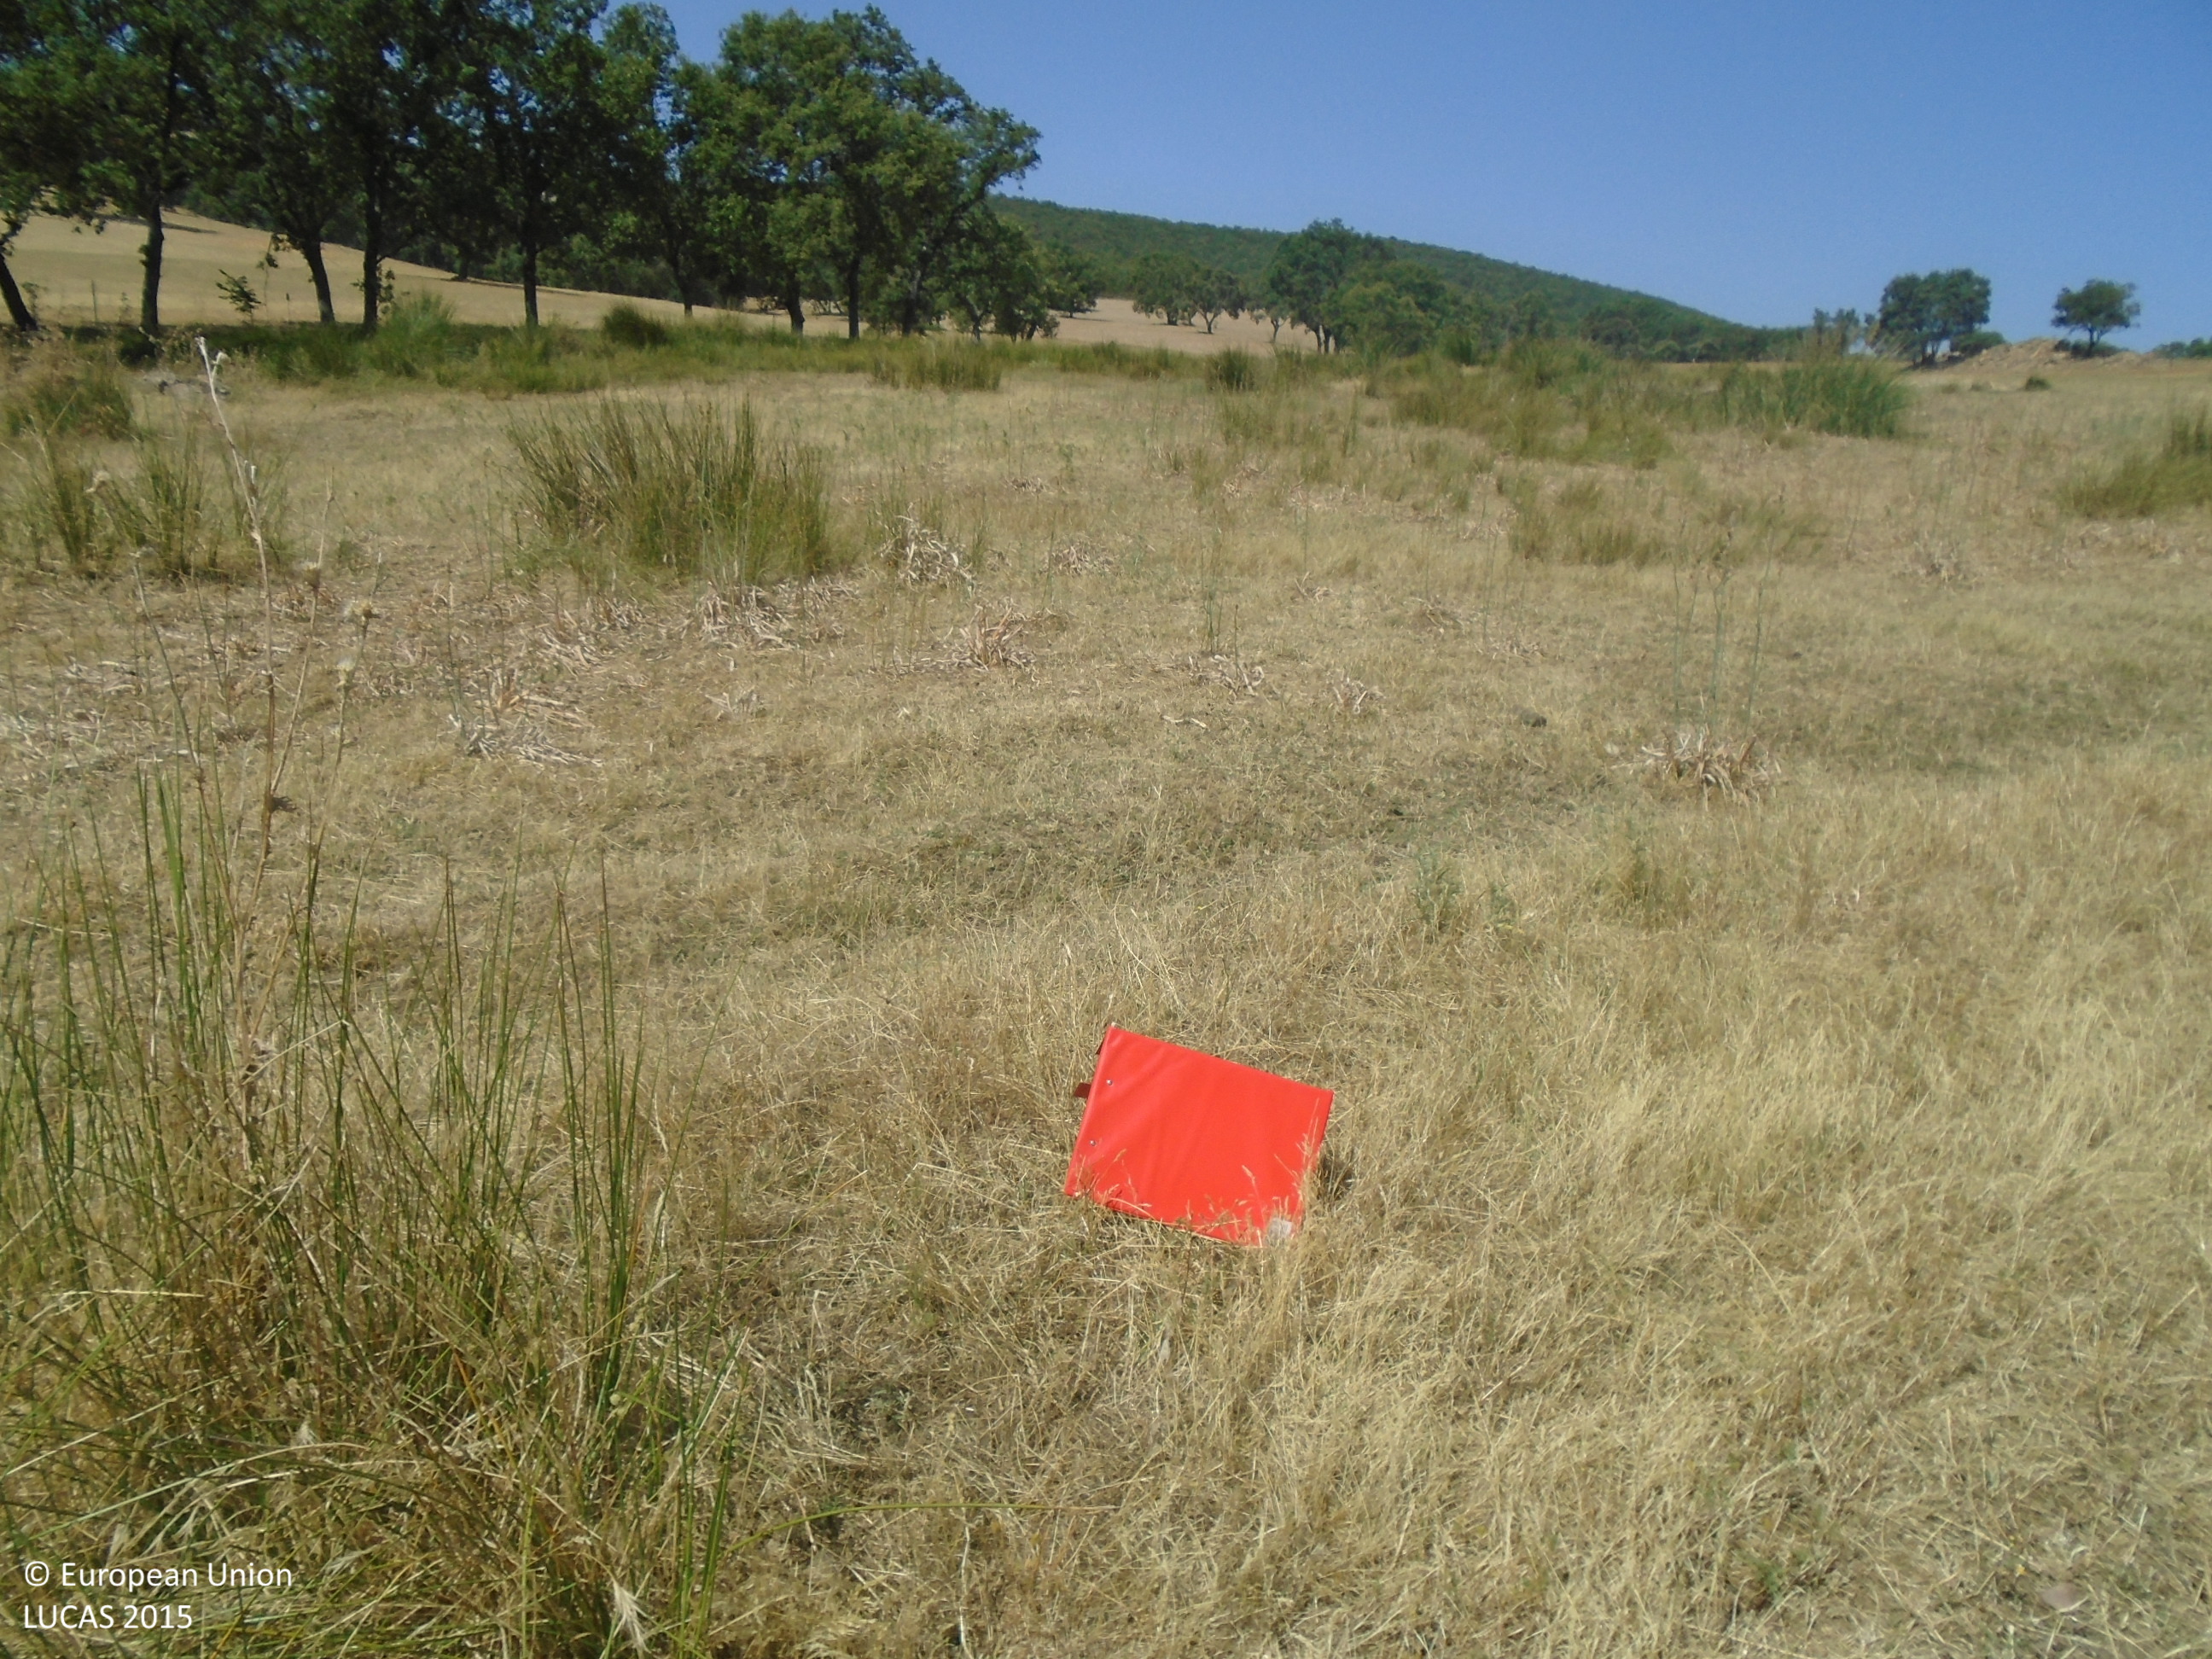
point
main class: Grassland
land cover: Spontaneously vegetated surfaces
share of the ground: > 75 %
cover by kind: herbaceous plants 100 %
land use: Semi-natural and natural areas not in use
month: July
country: ES
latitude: 39.3317
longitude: -4.1234
